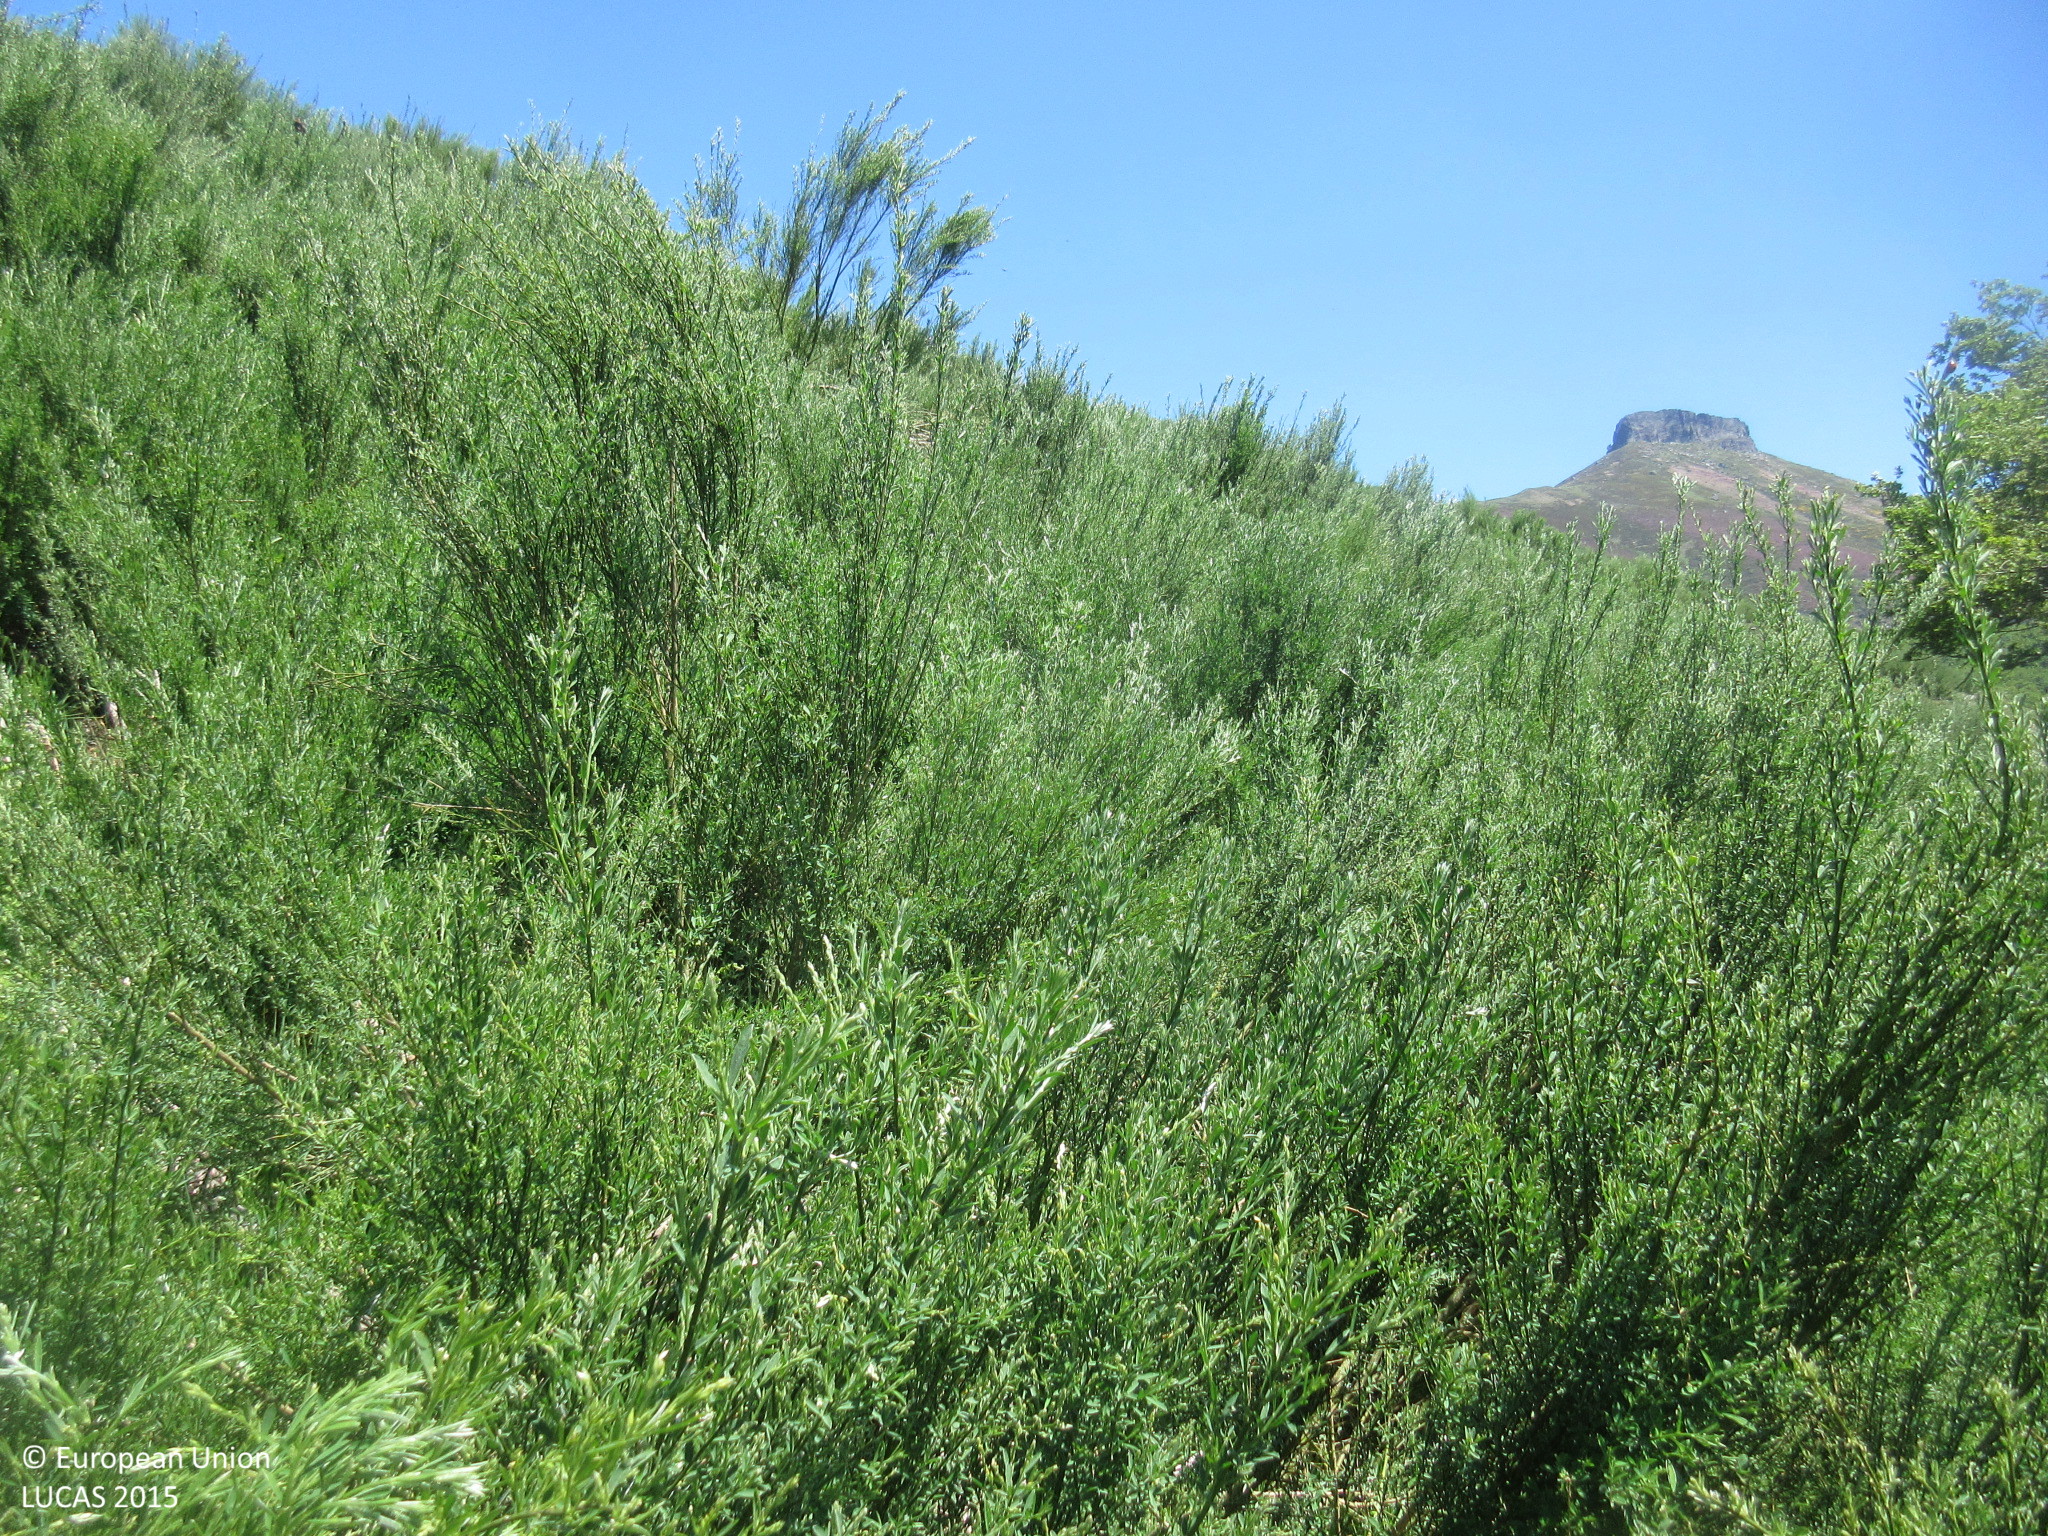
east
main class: Shrubland
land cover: Shrubland with sparse tree cover
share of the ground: > 75 %
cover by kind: shrubs 80 %, herbaceous plants 15 %, broadleaved forest trees 5 %
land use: Agriculture (excluding fallow land and kitchen gardens)
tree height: < 5 m
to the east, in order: Shrubland with sparse tree cover; Shrubland without tree cover; Fences; Shrubland without tree cover; Tracks; Shrubland without tree cover
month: June
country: ES
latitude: 43.0571
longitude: -4.4585
